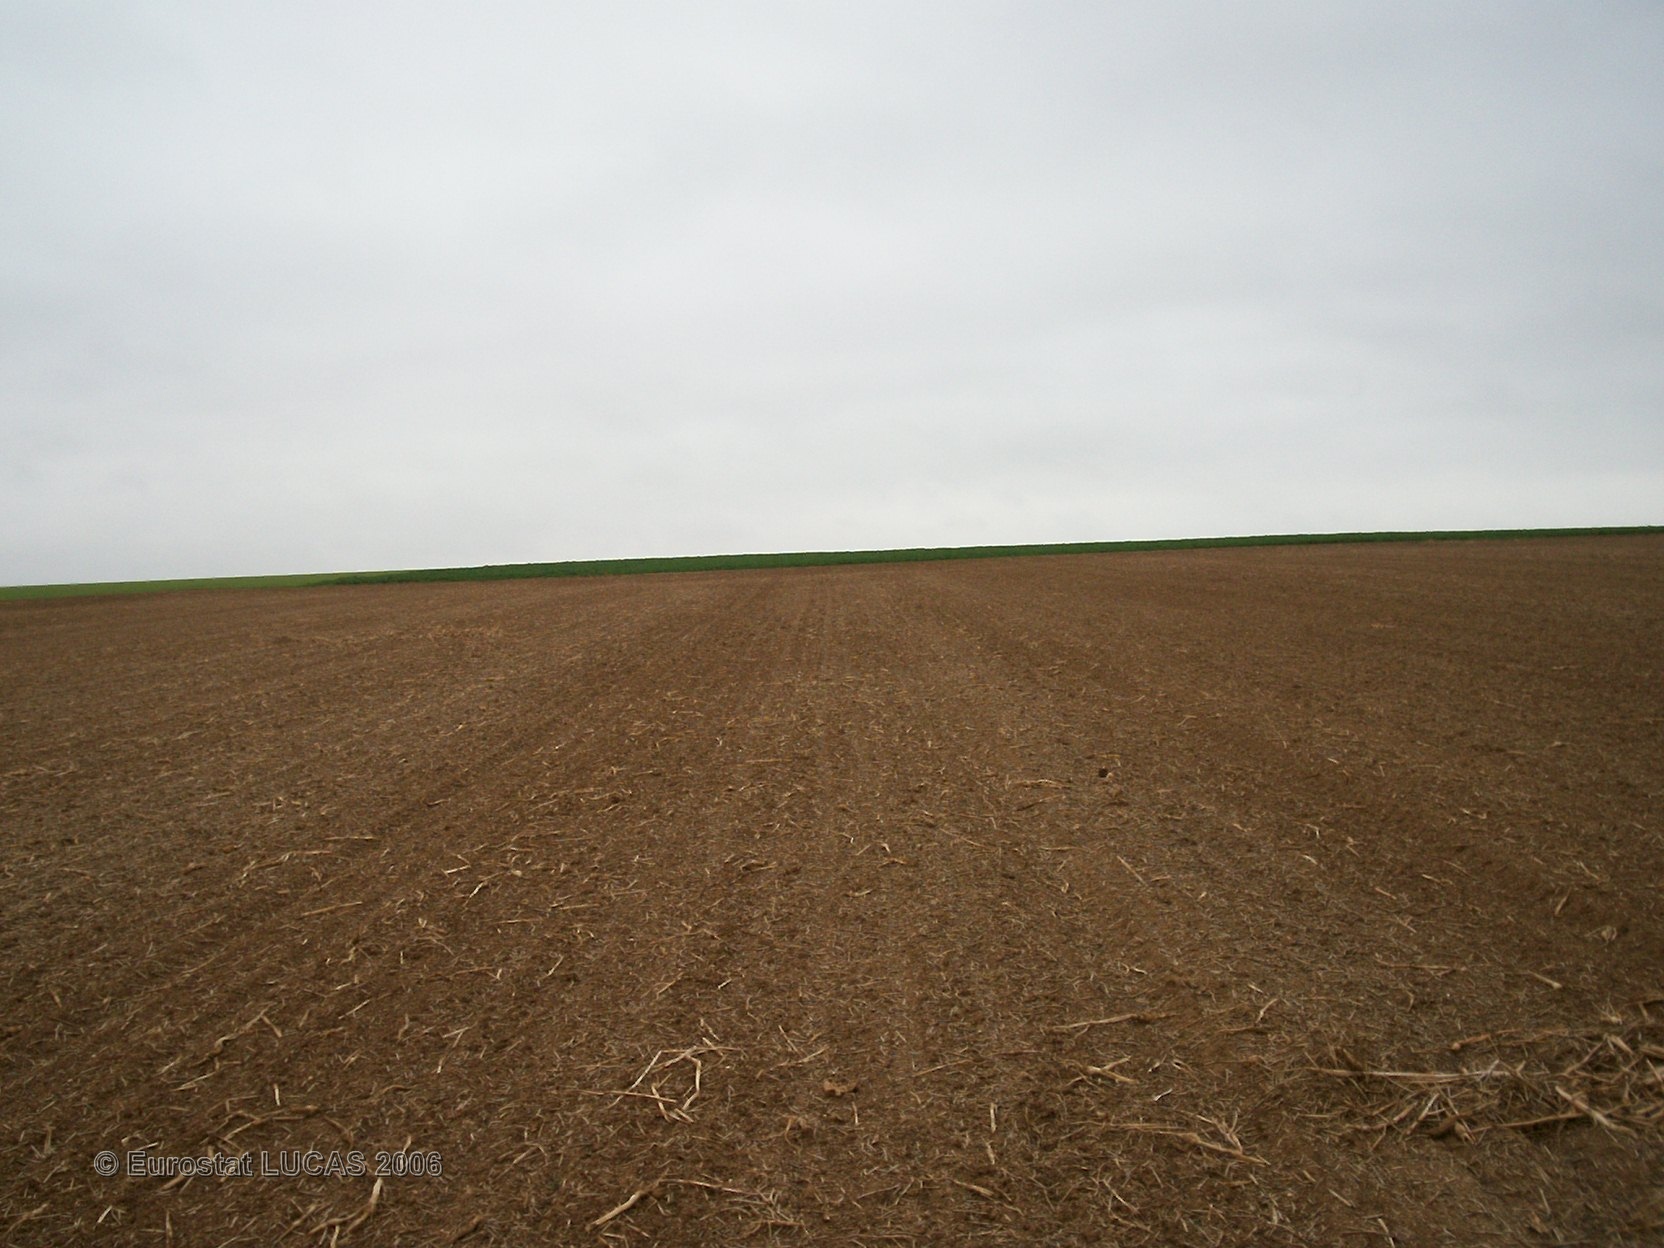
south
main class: Cropland
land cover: Sugar beet
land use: Agriculture (excluding fallow land and kitchen gardens)
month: April
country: FR
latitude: 49.2729
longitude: 4.4298
